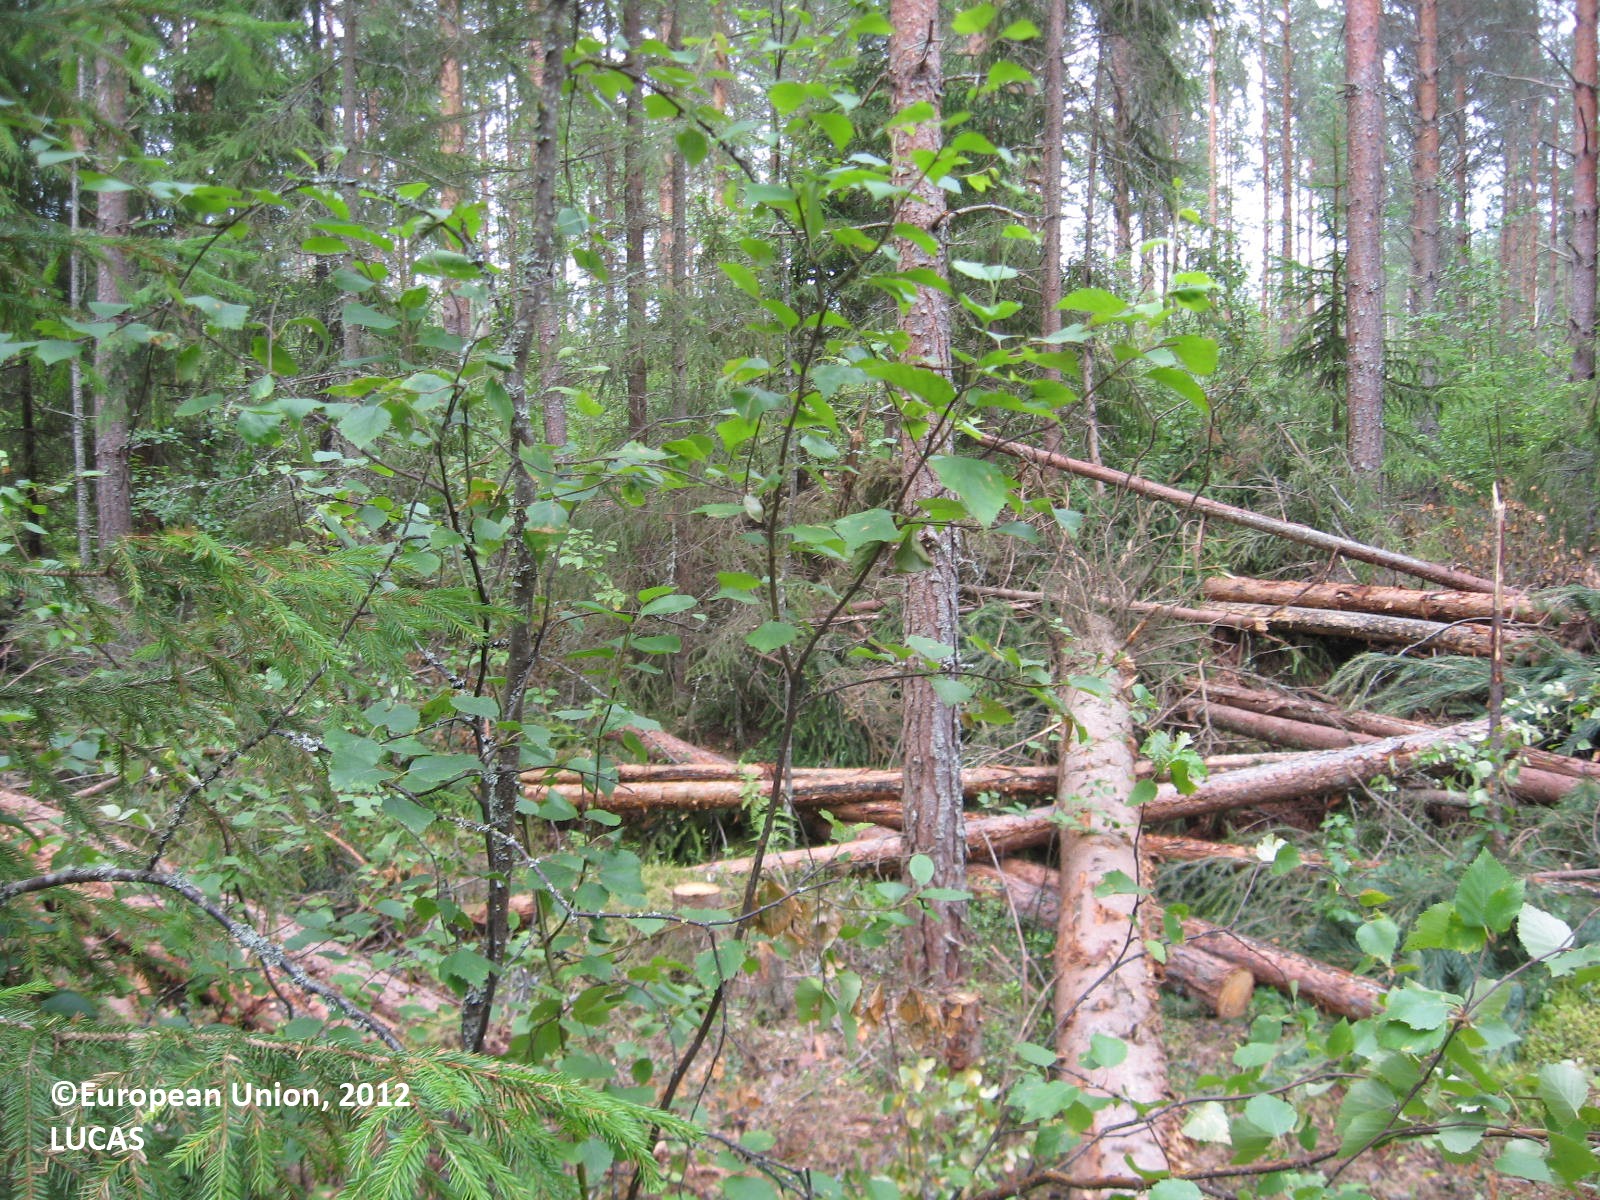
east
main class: Woodland
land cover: Other coniferous woodland
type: boreal forest
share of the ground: > 75 %
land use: Forestry
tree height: > 5 m
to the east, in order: Other coniferous woodland; Ditches and canals; Pine dominated coniferous woodland; Ditches and canals; Other mixed woodland; Spruce dominated mixed woodland; Ditches and canals; Spruce dominated mixed woodland
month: July
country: FI
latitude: 61.9155
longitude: 21.4912
